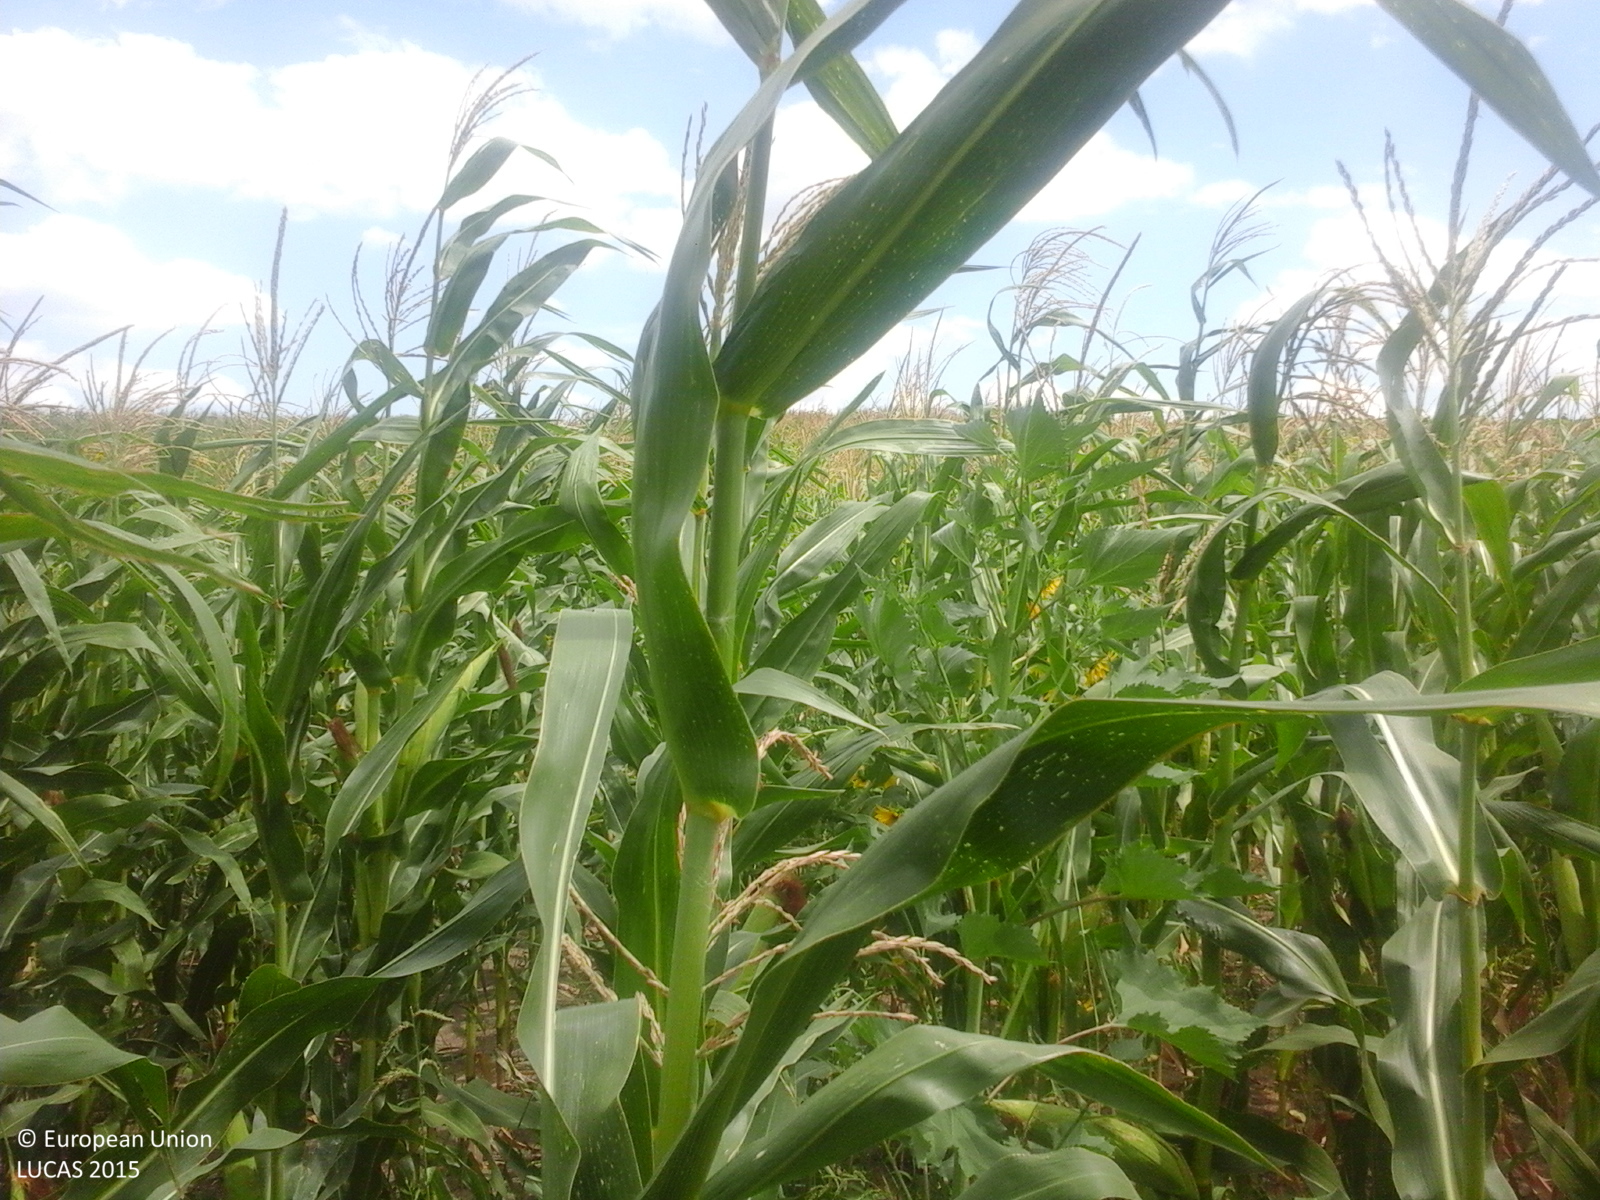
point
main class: Cropland
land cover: Maize
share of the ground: > 75 %
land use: Agriculture (excluding fallow land and kitchen gardens)
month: July
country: RO
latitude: 46.5227
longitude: 27.9985
